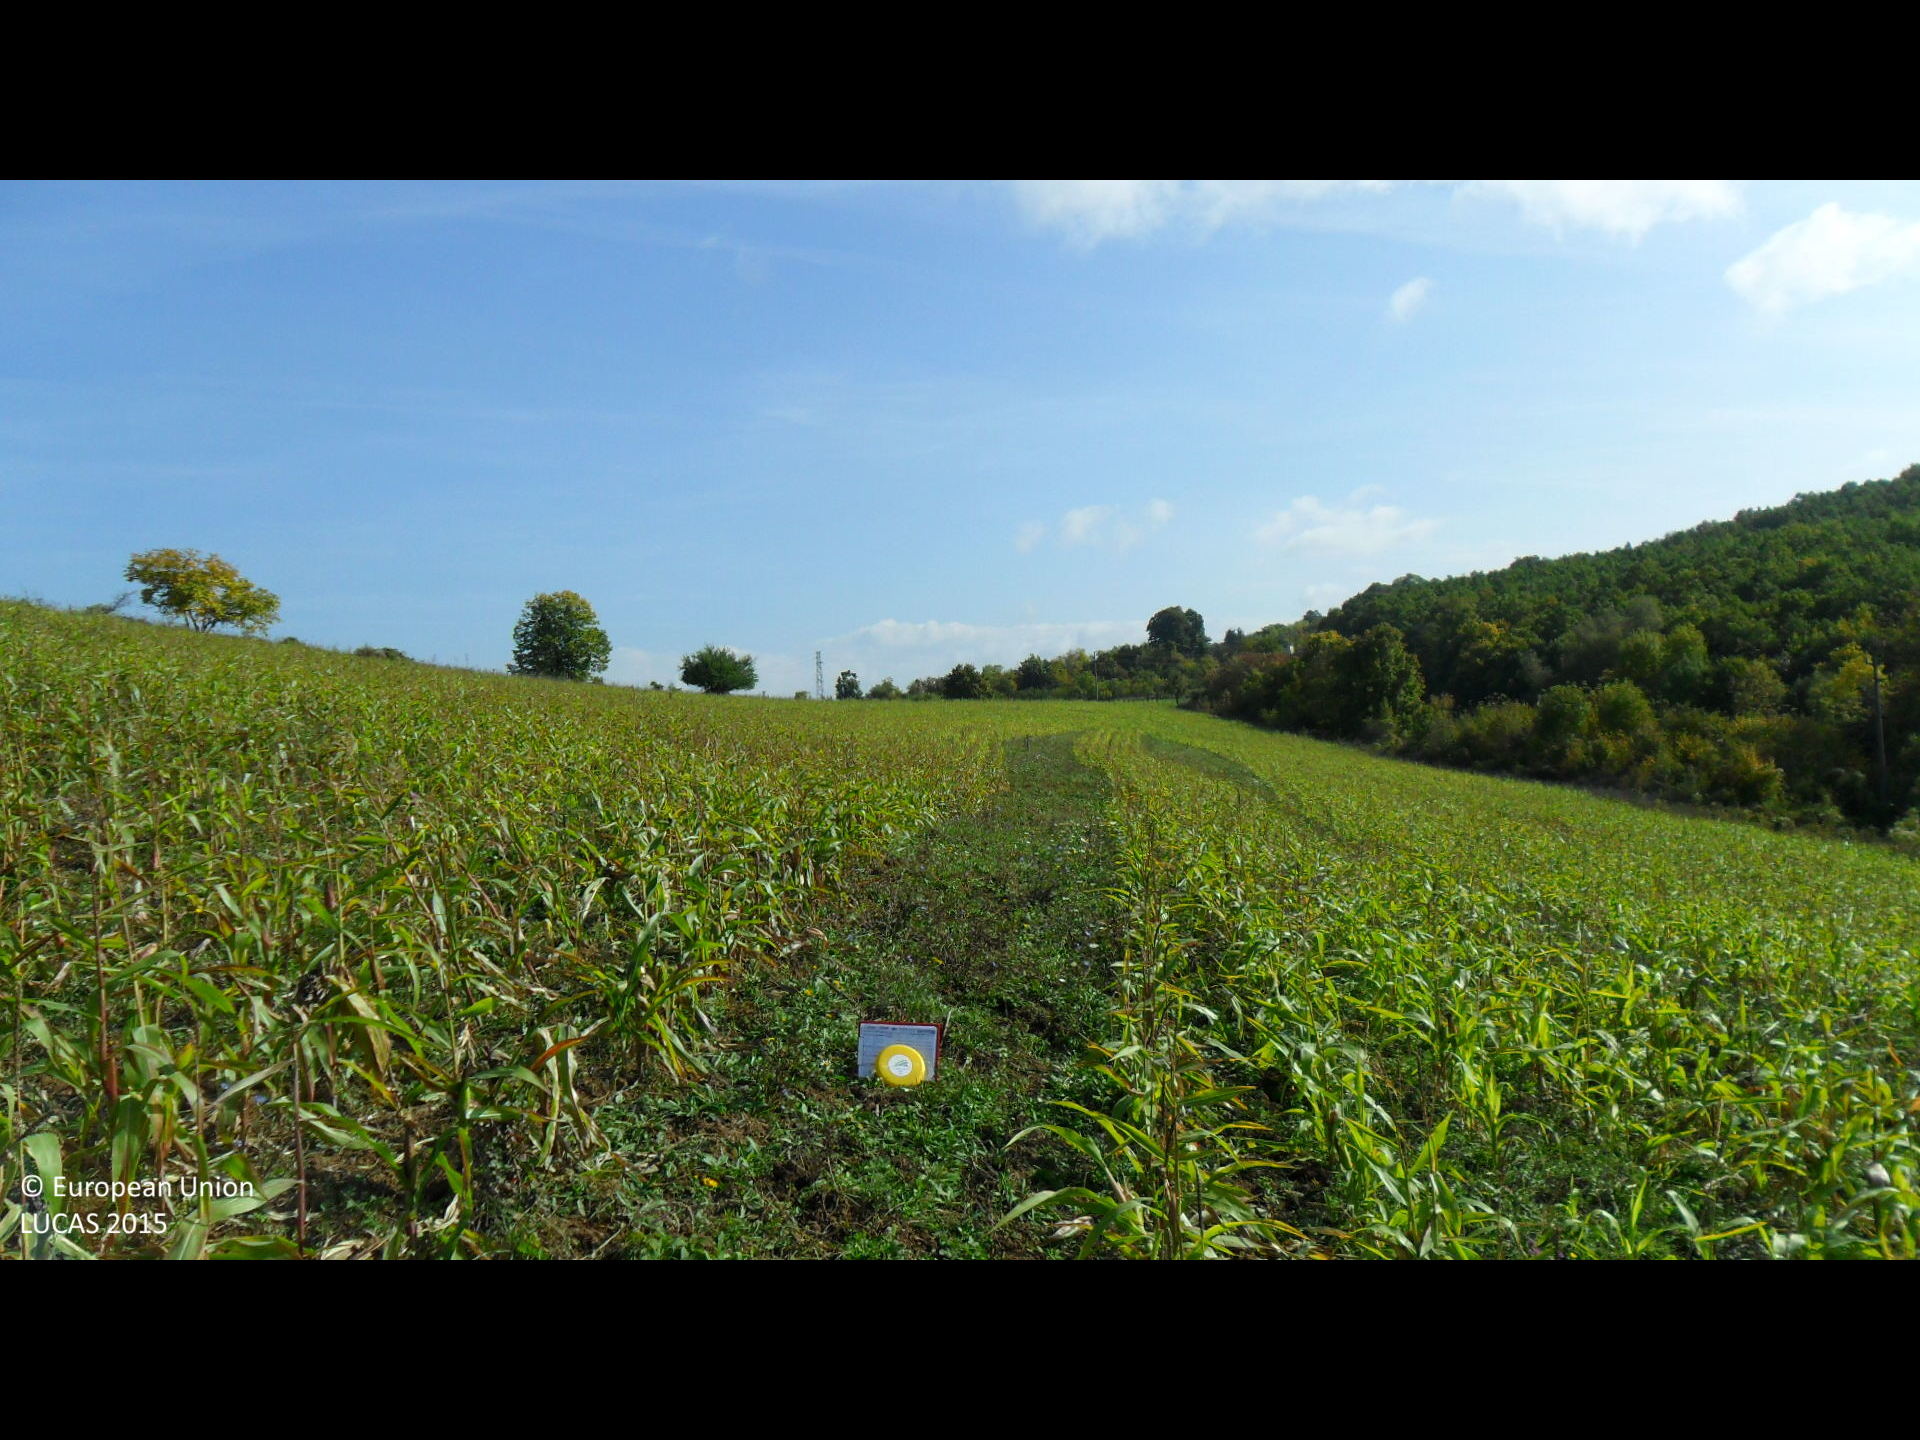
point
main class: Cropland
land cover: Maize
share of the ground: > 75 %
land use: Agriculture (excluding fallow land and kitchen gardens)
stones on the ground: < 10 %
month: October
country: BG
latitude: 43.0940
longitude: 26.1485
